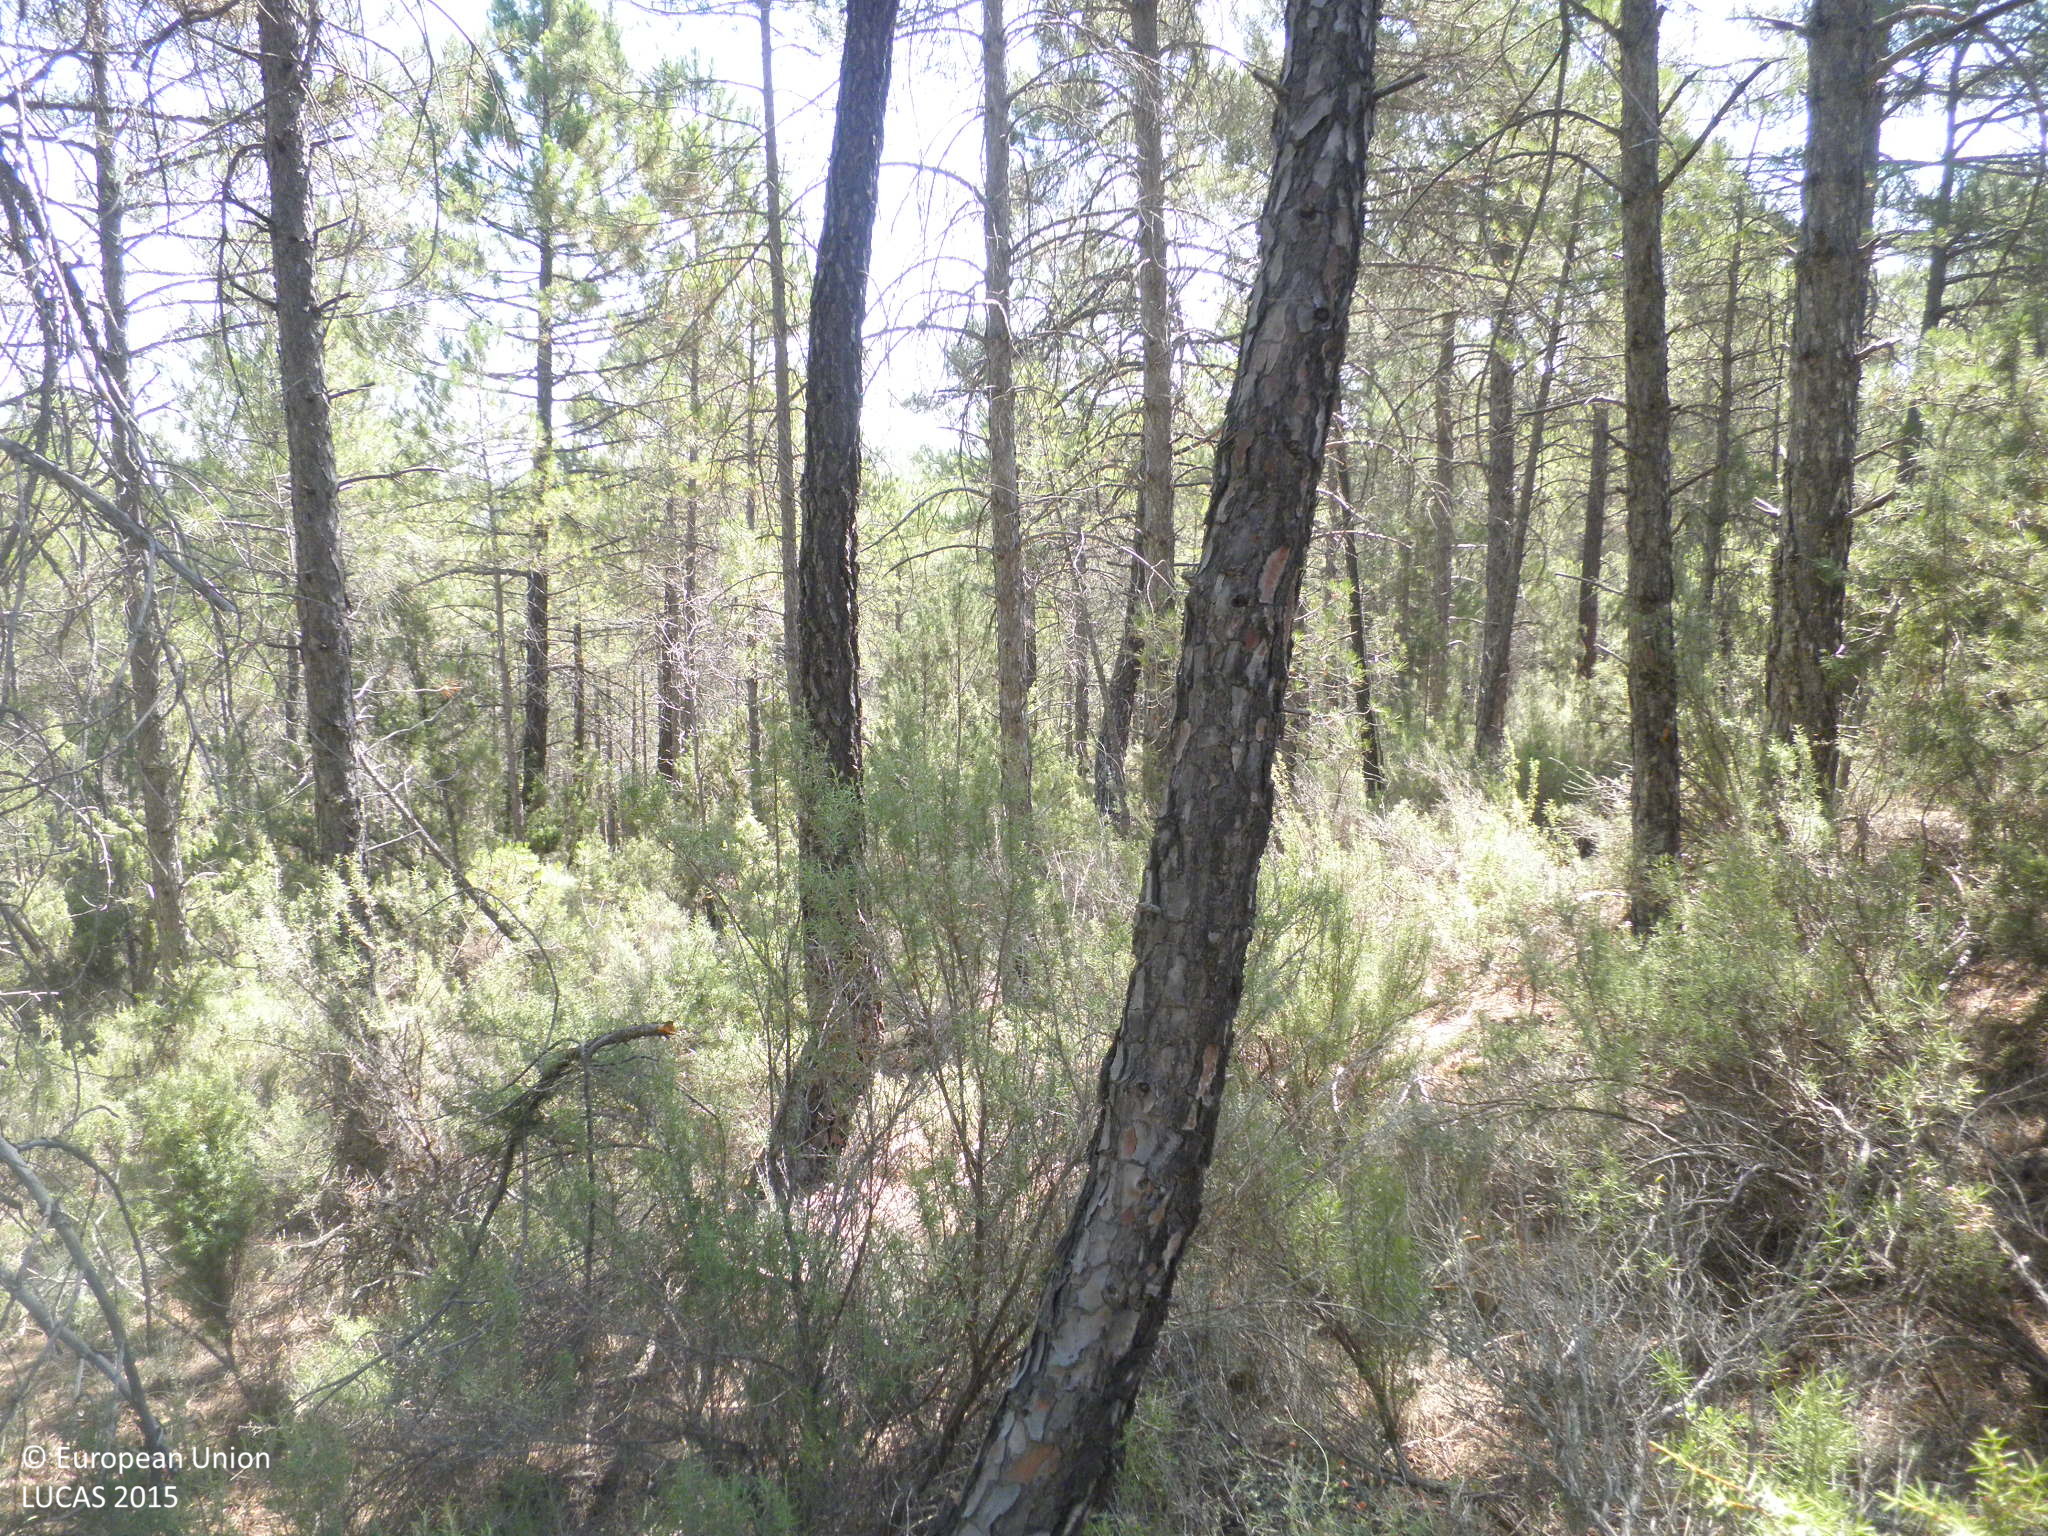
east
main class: Woodland
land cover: Pine dominated coniferous woodland
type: coniferous forest of the mediterranean region
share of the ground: 50 - 75 %
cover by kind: coniferous forest trees 60 %, unconsolidated bare surface 20 %, shrubs 15 %, herbaceous plants 5 %
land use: Semi-natural and natural areas not in use
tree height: > 5 m
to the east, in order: Pine dominated coniferous woodland; Spontaneously vegetated surfaces
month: July
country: ES
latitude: 39.6866
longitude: -1.7498
